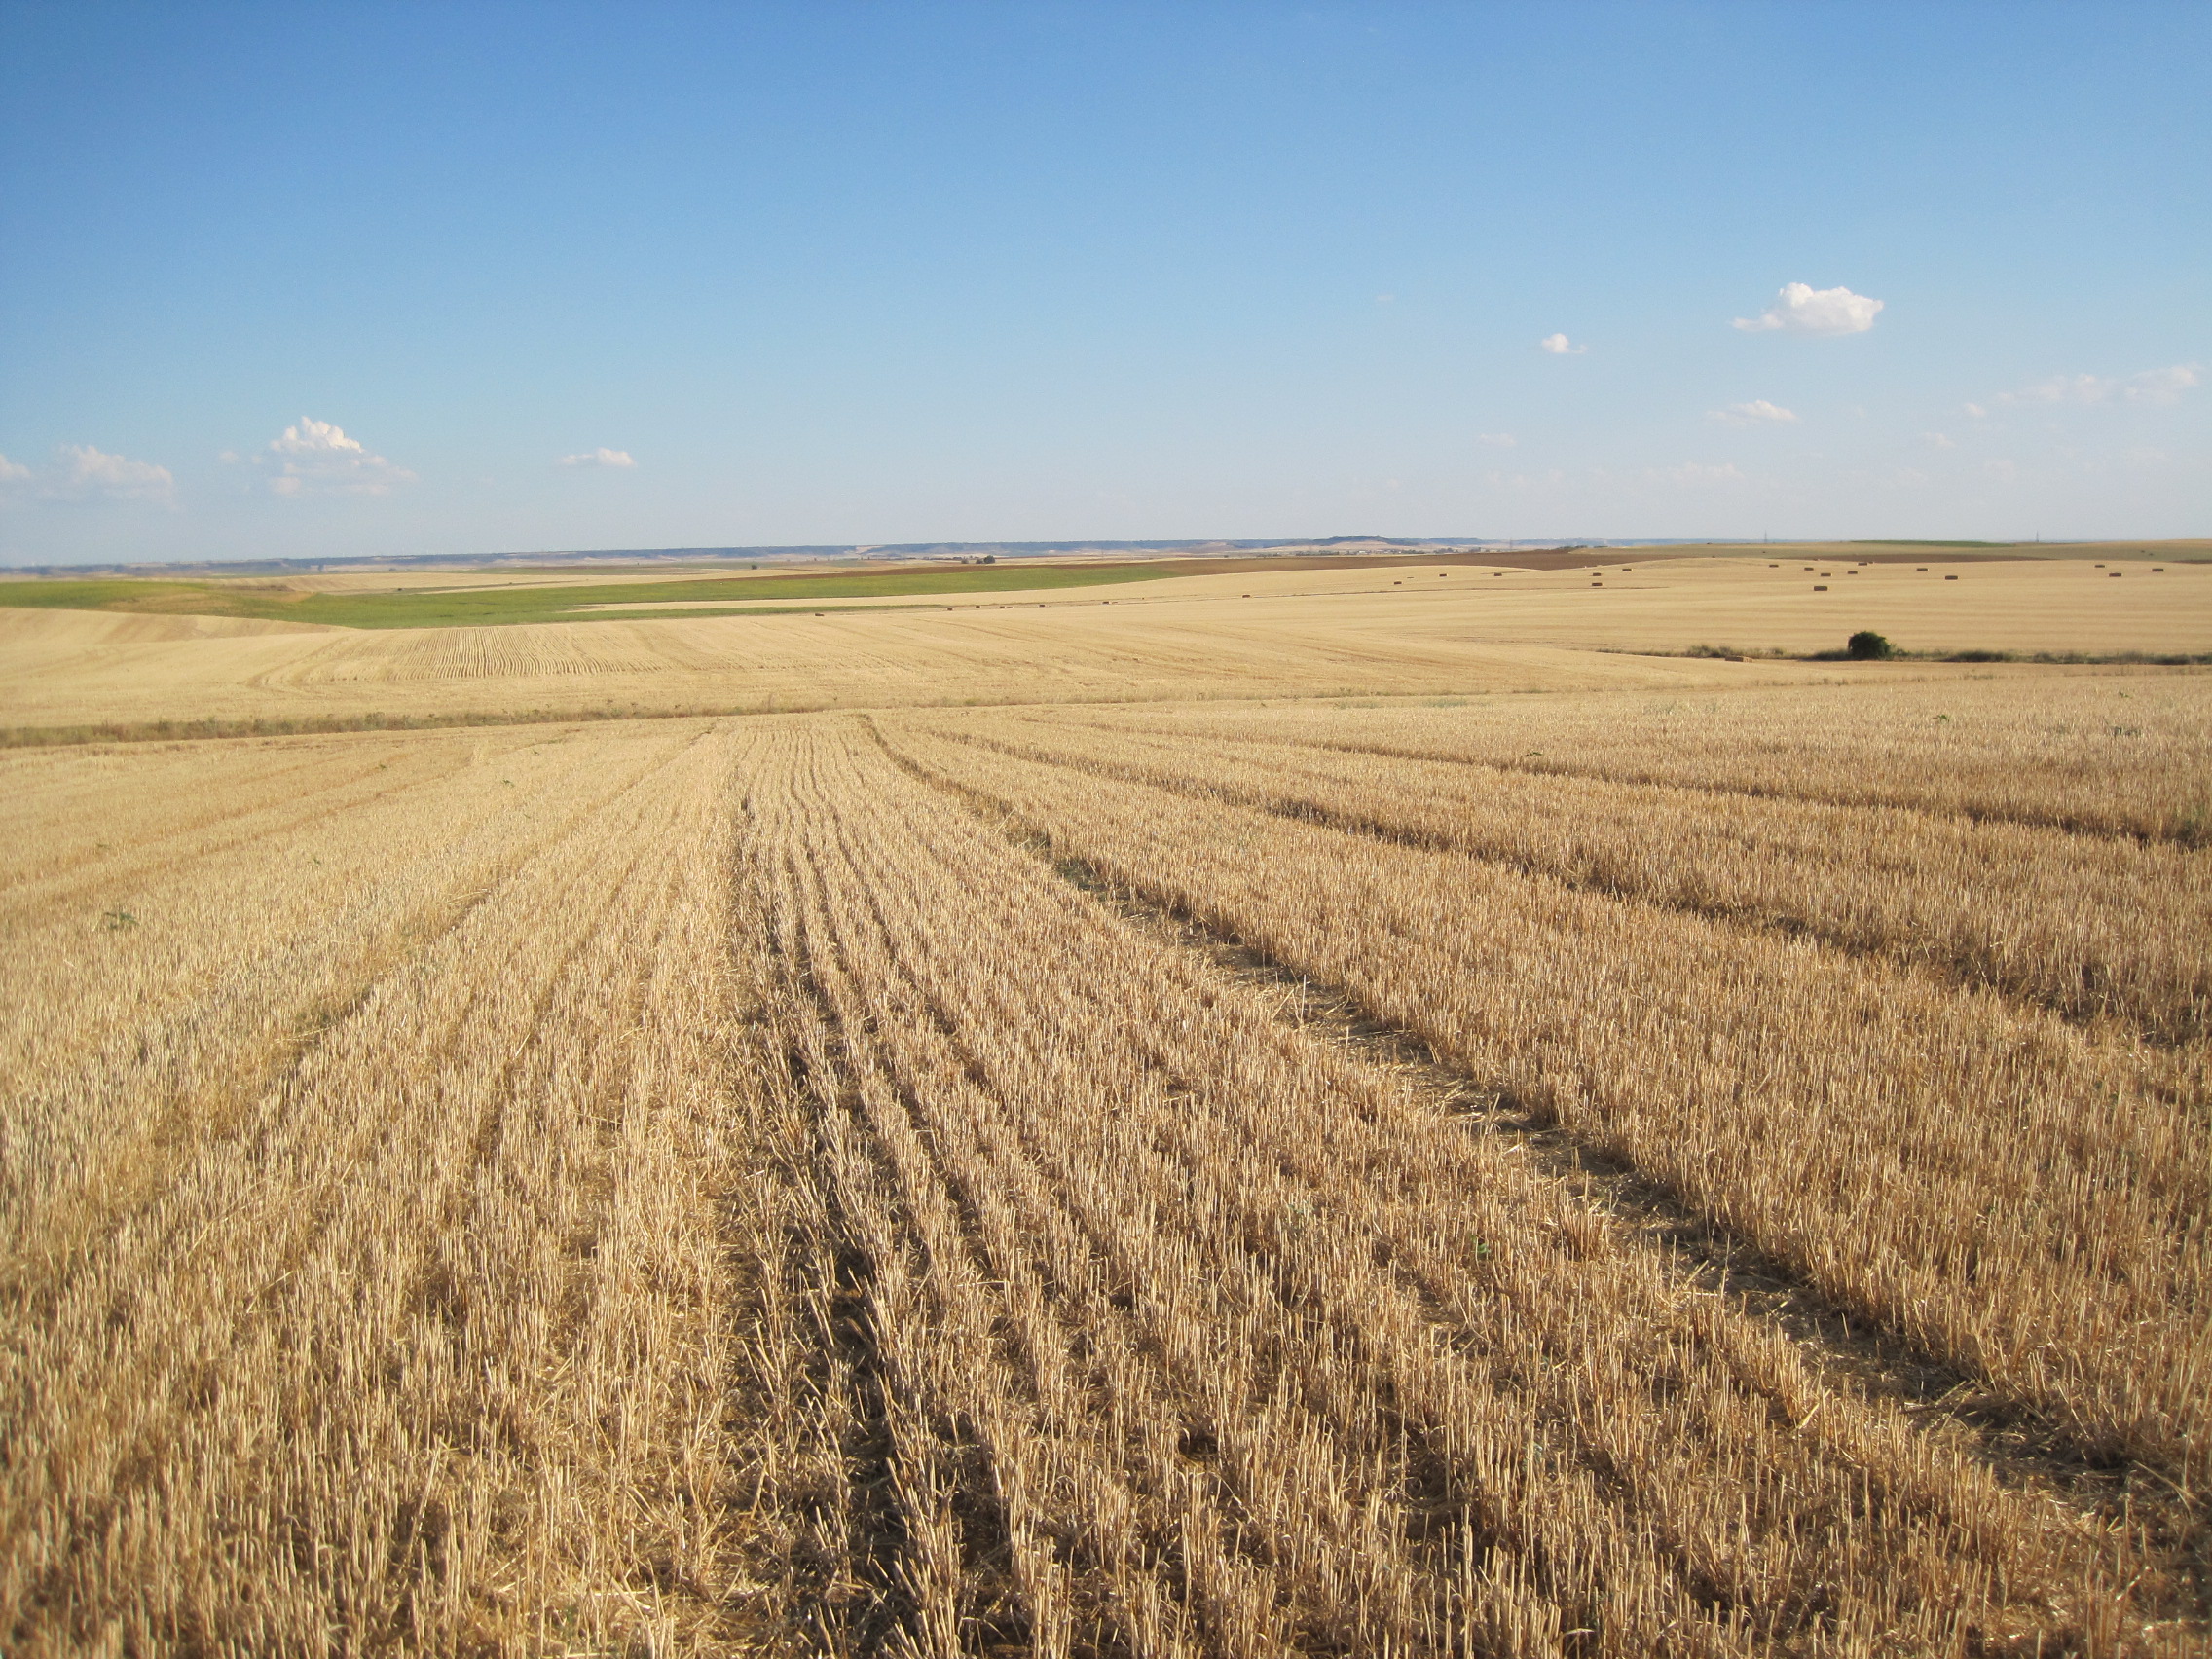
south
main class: Cropland
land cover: Barley
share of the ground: < 10 %
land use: Agriculture (excluding fallow land and kitchen gardens)
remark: Harvested field
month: July
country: ES
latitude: 41.9262
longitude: -5.1663
